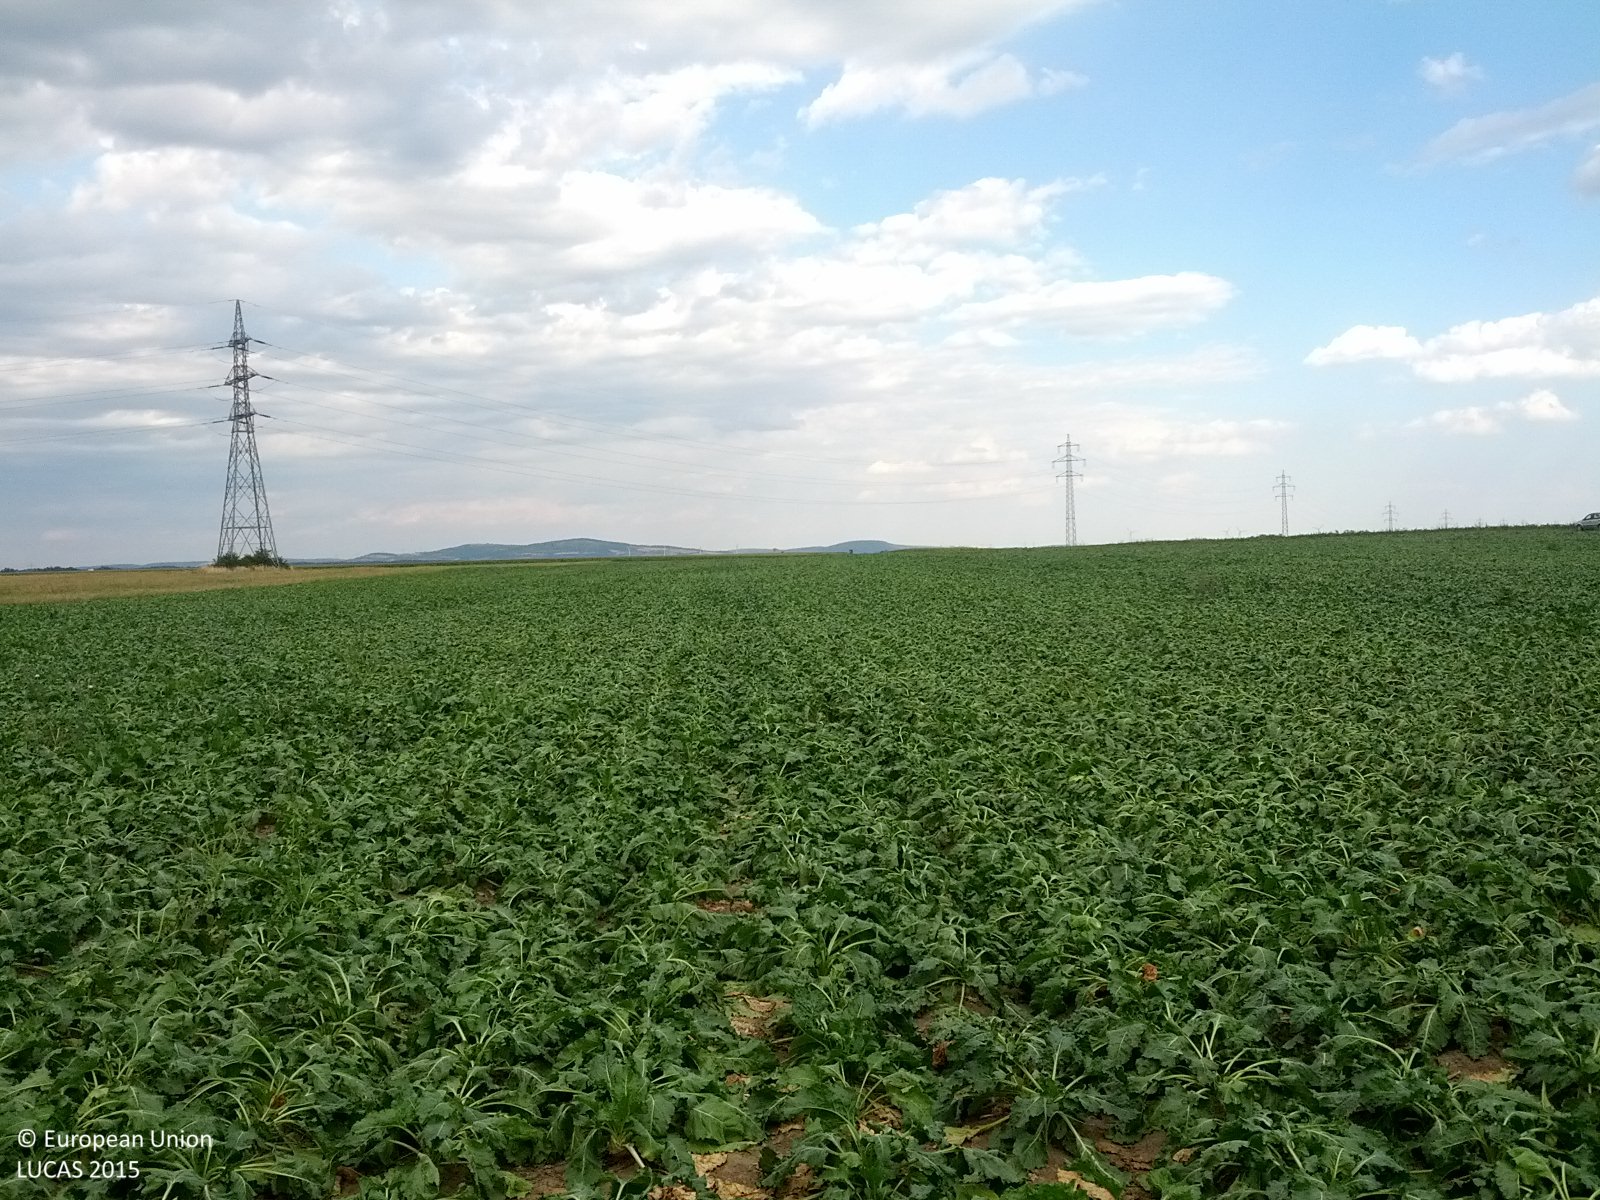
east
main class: Cropland
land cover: Sugar beet
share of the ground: > 75 %
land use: Agriculture (excluding fallow land and kitchen gardens)
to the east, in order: Sugar beet
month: July
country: AT
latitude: 48.4141
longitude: 16.1249
